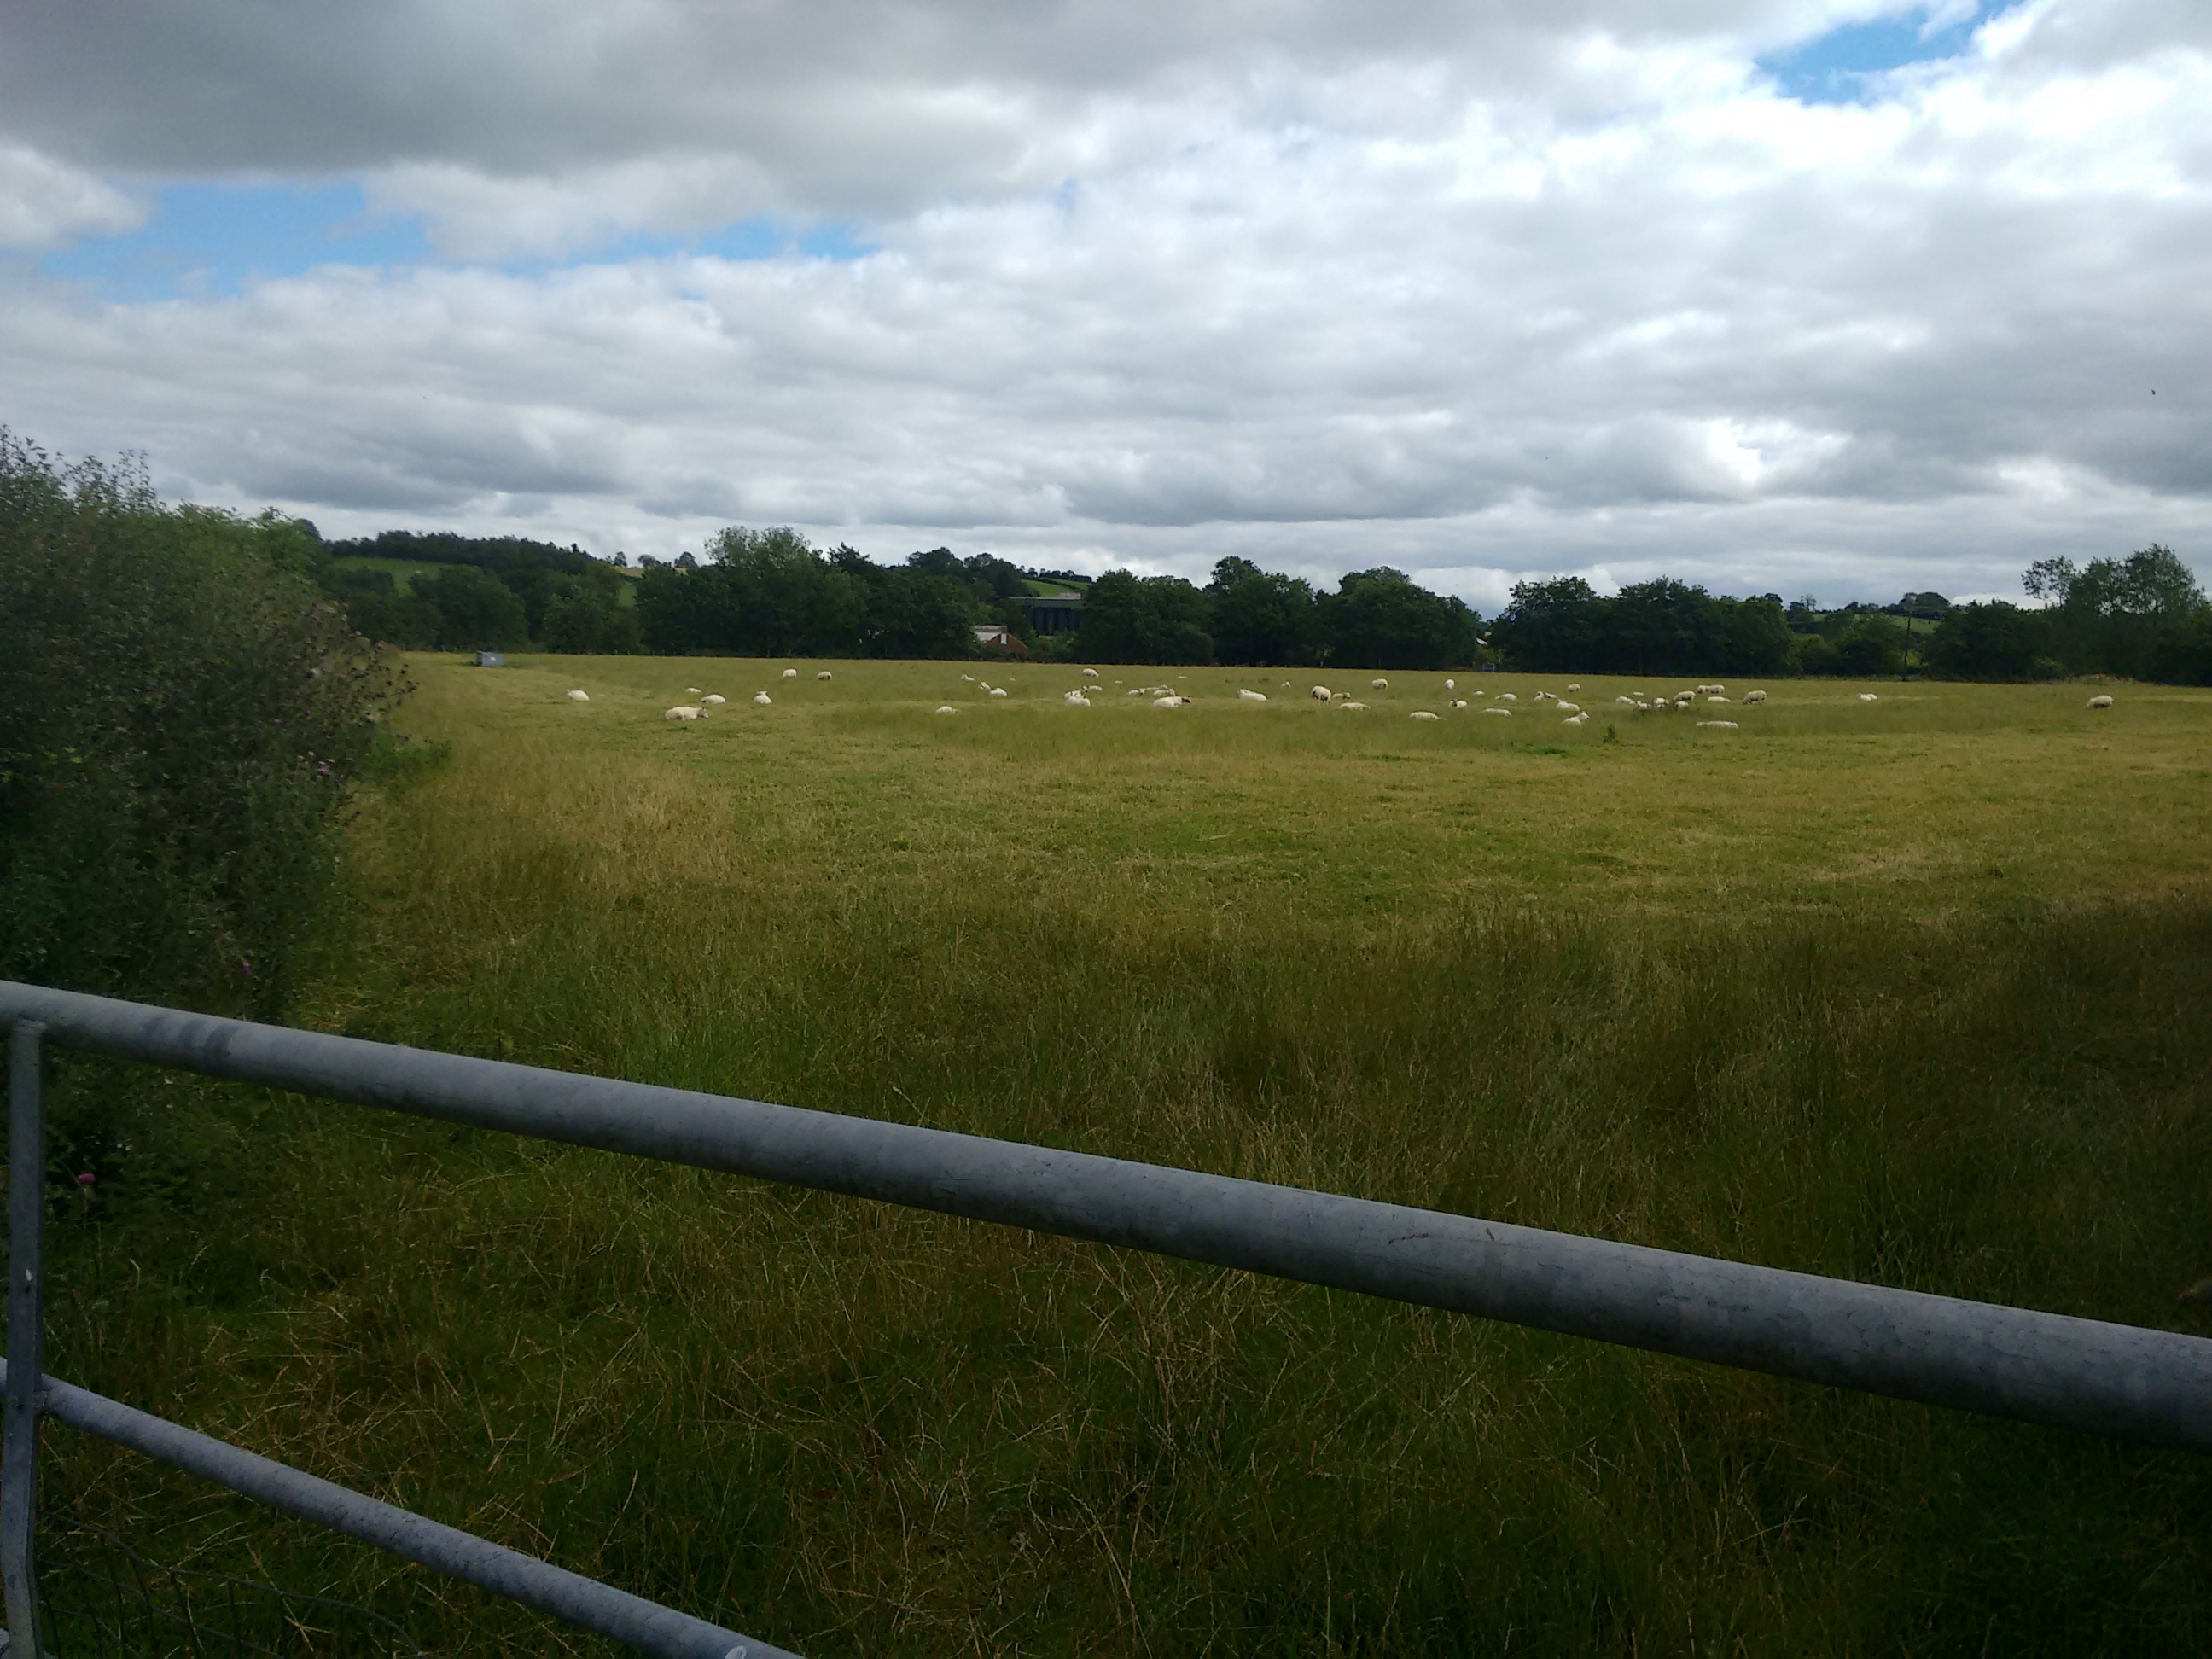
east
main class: Grassland
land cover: Grassland without tree/shrub cover
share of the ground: > 75 %
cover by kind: herbaceous plants 100 %
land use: Agriculture (excluding fallow land and kitchen gardens)
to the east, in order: Grassland without tree/shrub cover; Managed hedges; Single bushes/trees; Grass margins; Rivers and streams; Grass margins; Single bushes/trees; Fences; Grassland without tree/shrub cover; Fences; Single bushes/trees; Artificial constructions in urban areas
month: August
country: GB
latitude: 54.4416
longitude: -6.8019
